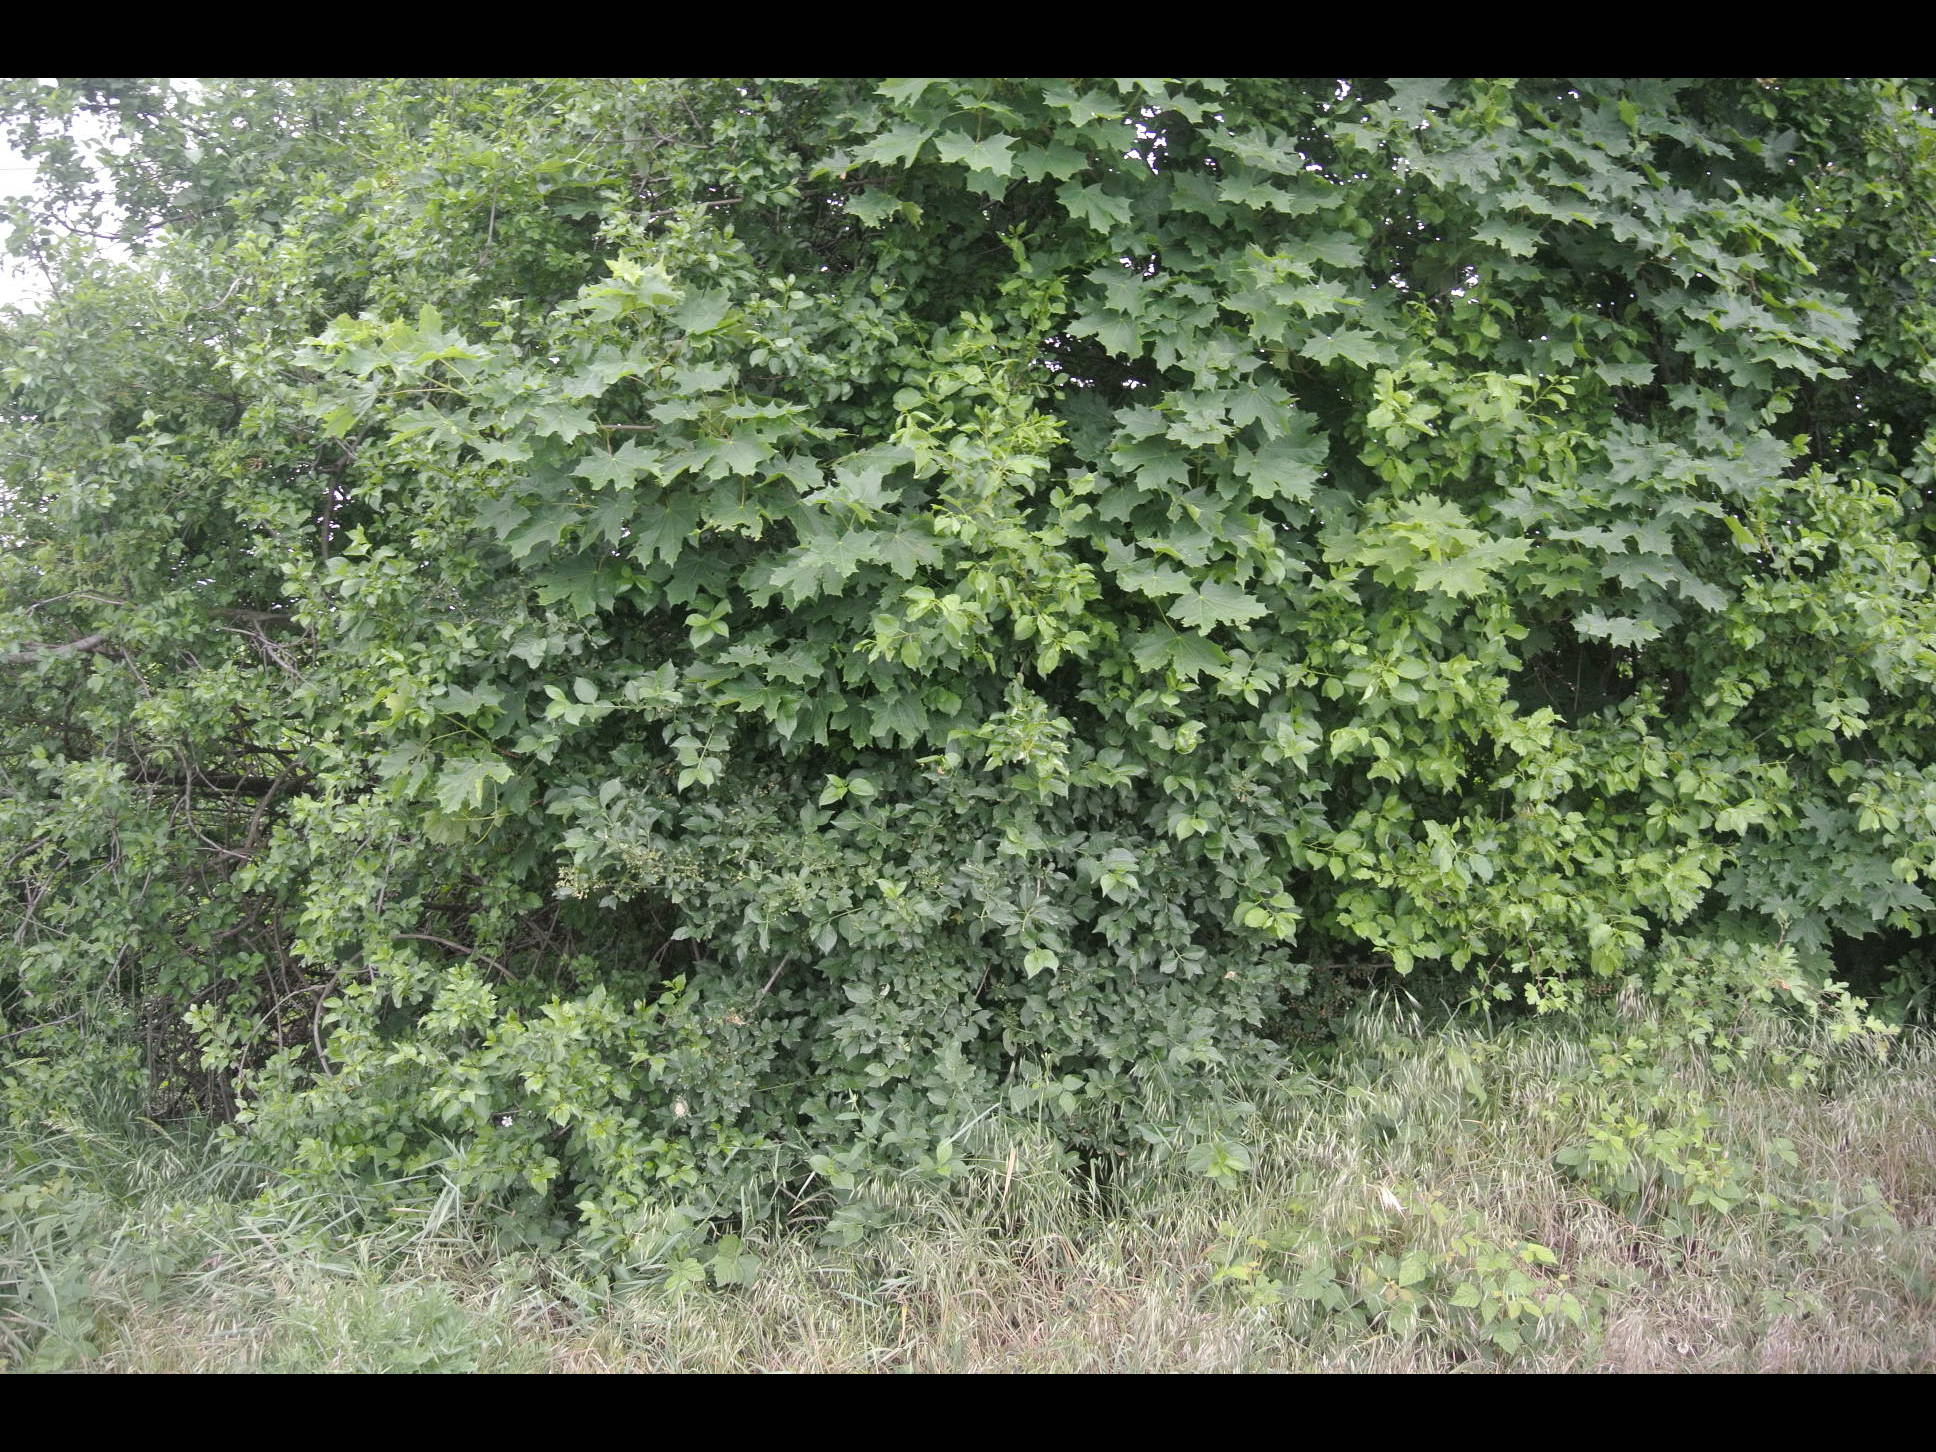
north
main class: Woodland
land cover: Broadleaved woodland
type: beech forest
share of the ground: > 75 %
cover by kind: broadleaved forest trees 100 %
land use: Semi-natural and natural areas not in use
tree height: > 5 m
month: May
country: AT
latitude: 48.0247
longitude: 16.6162
